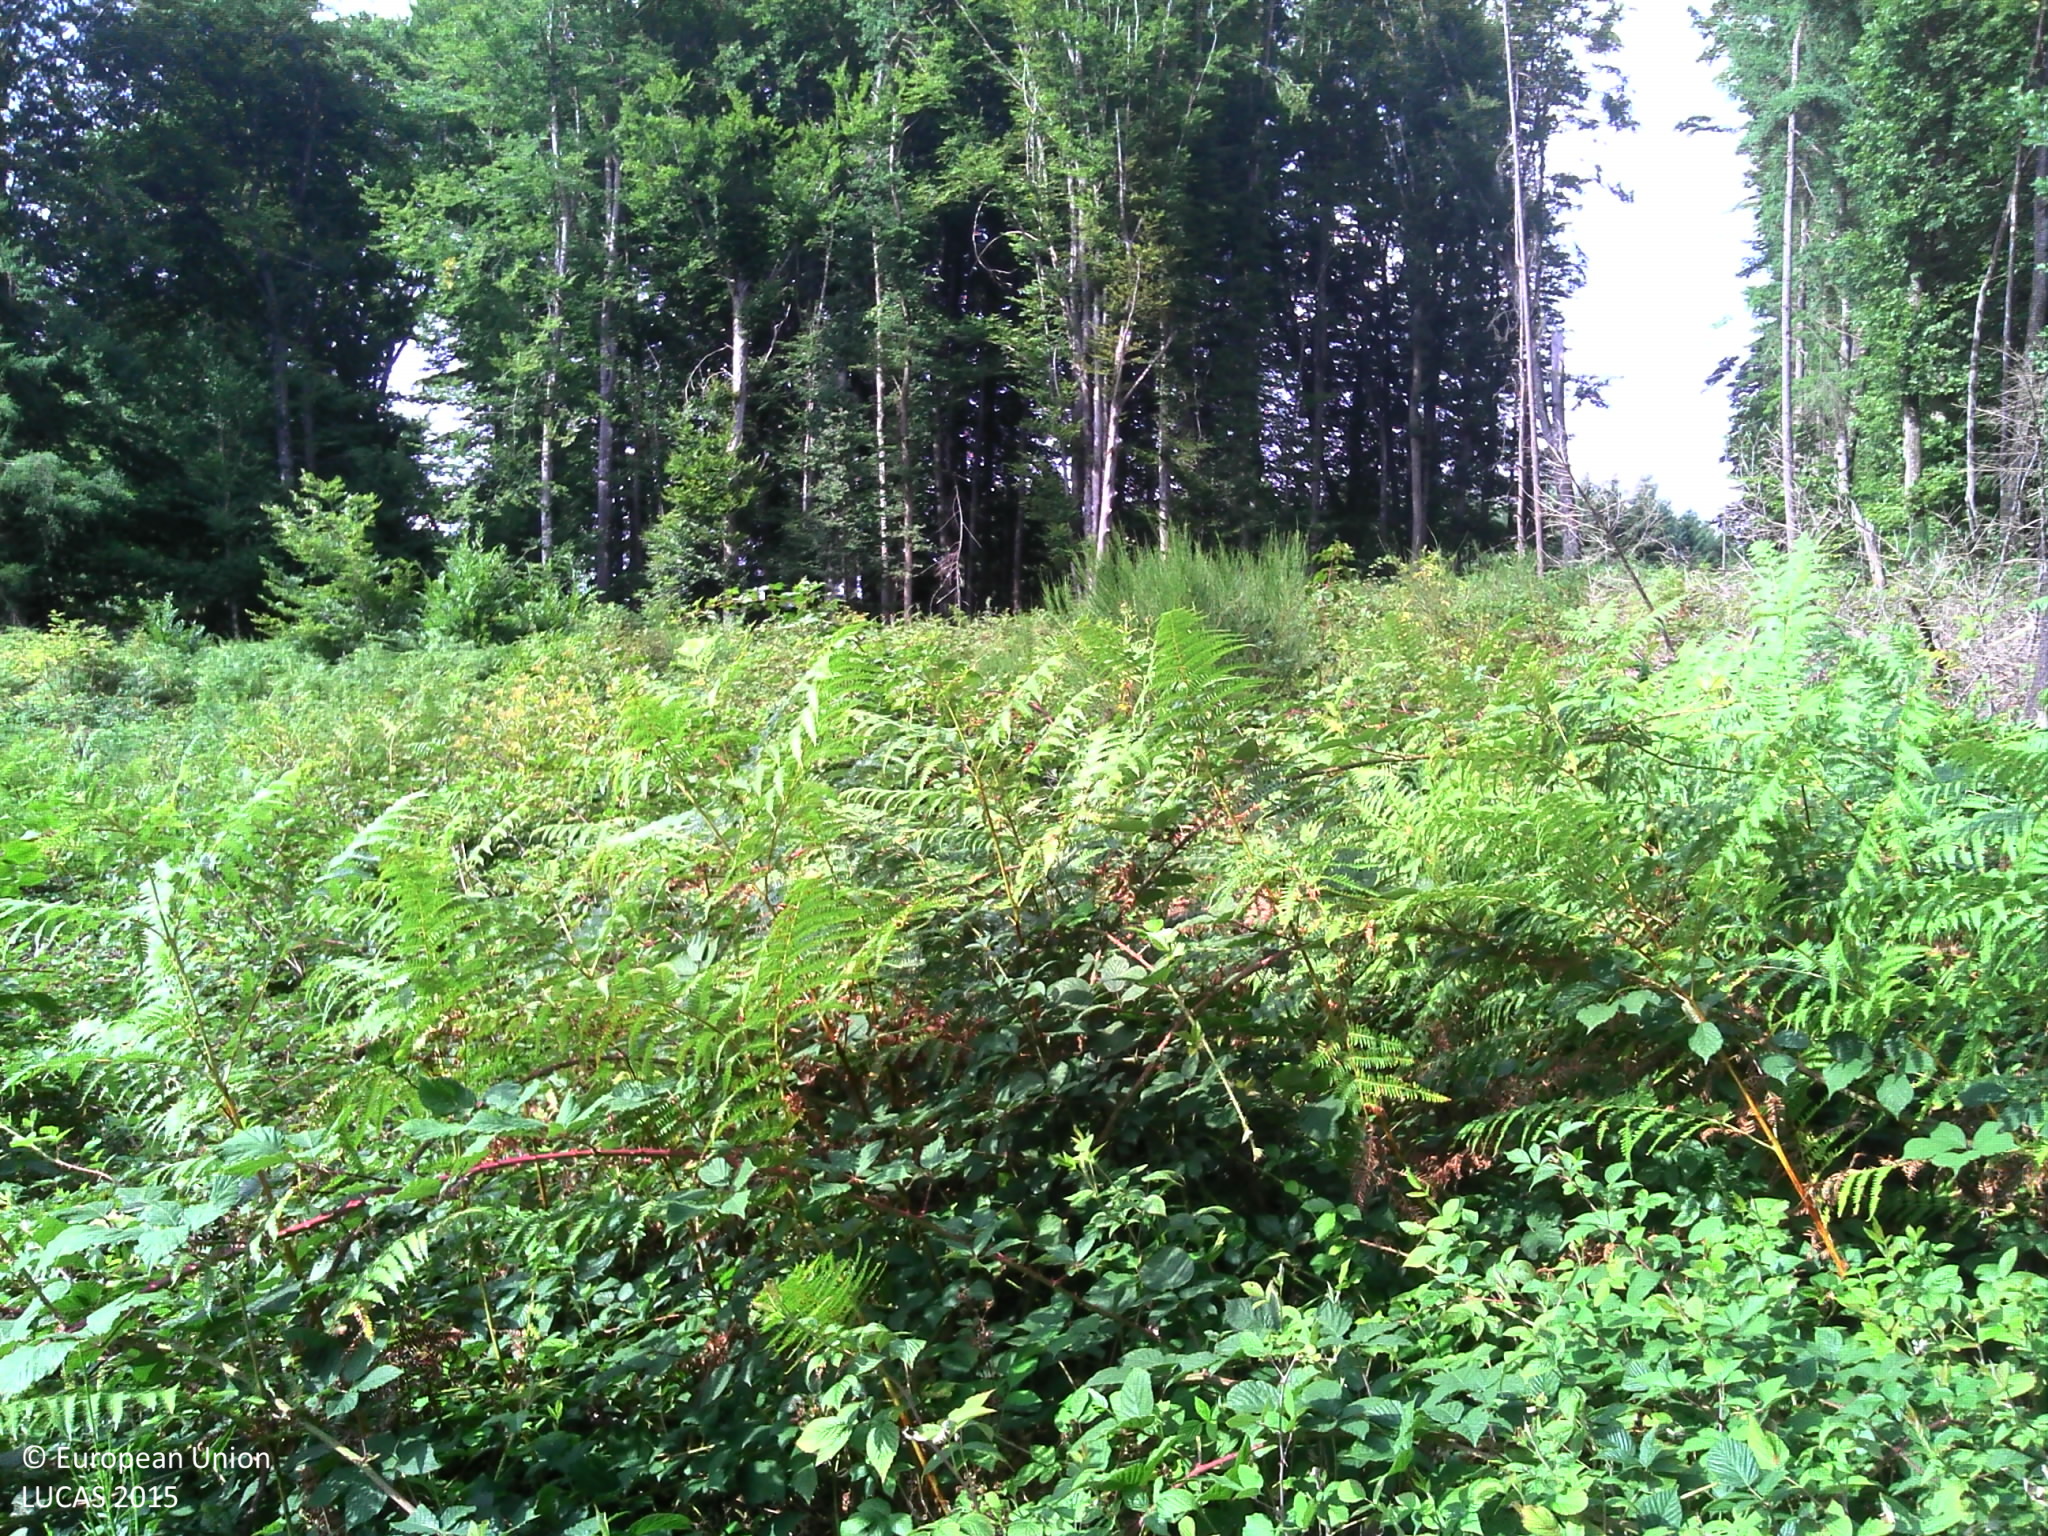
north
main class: Shrubland
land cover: Shrubland without tree cover
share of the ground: > 75 %
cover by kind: shrubs 80 %, herbaceous plants 20 %
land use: Forestry
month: August
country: FR
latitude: 46.2951
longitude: 4.4066
